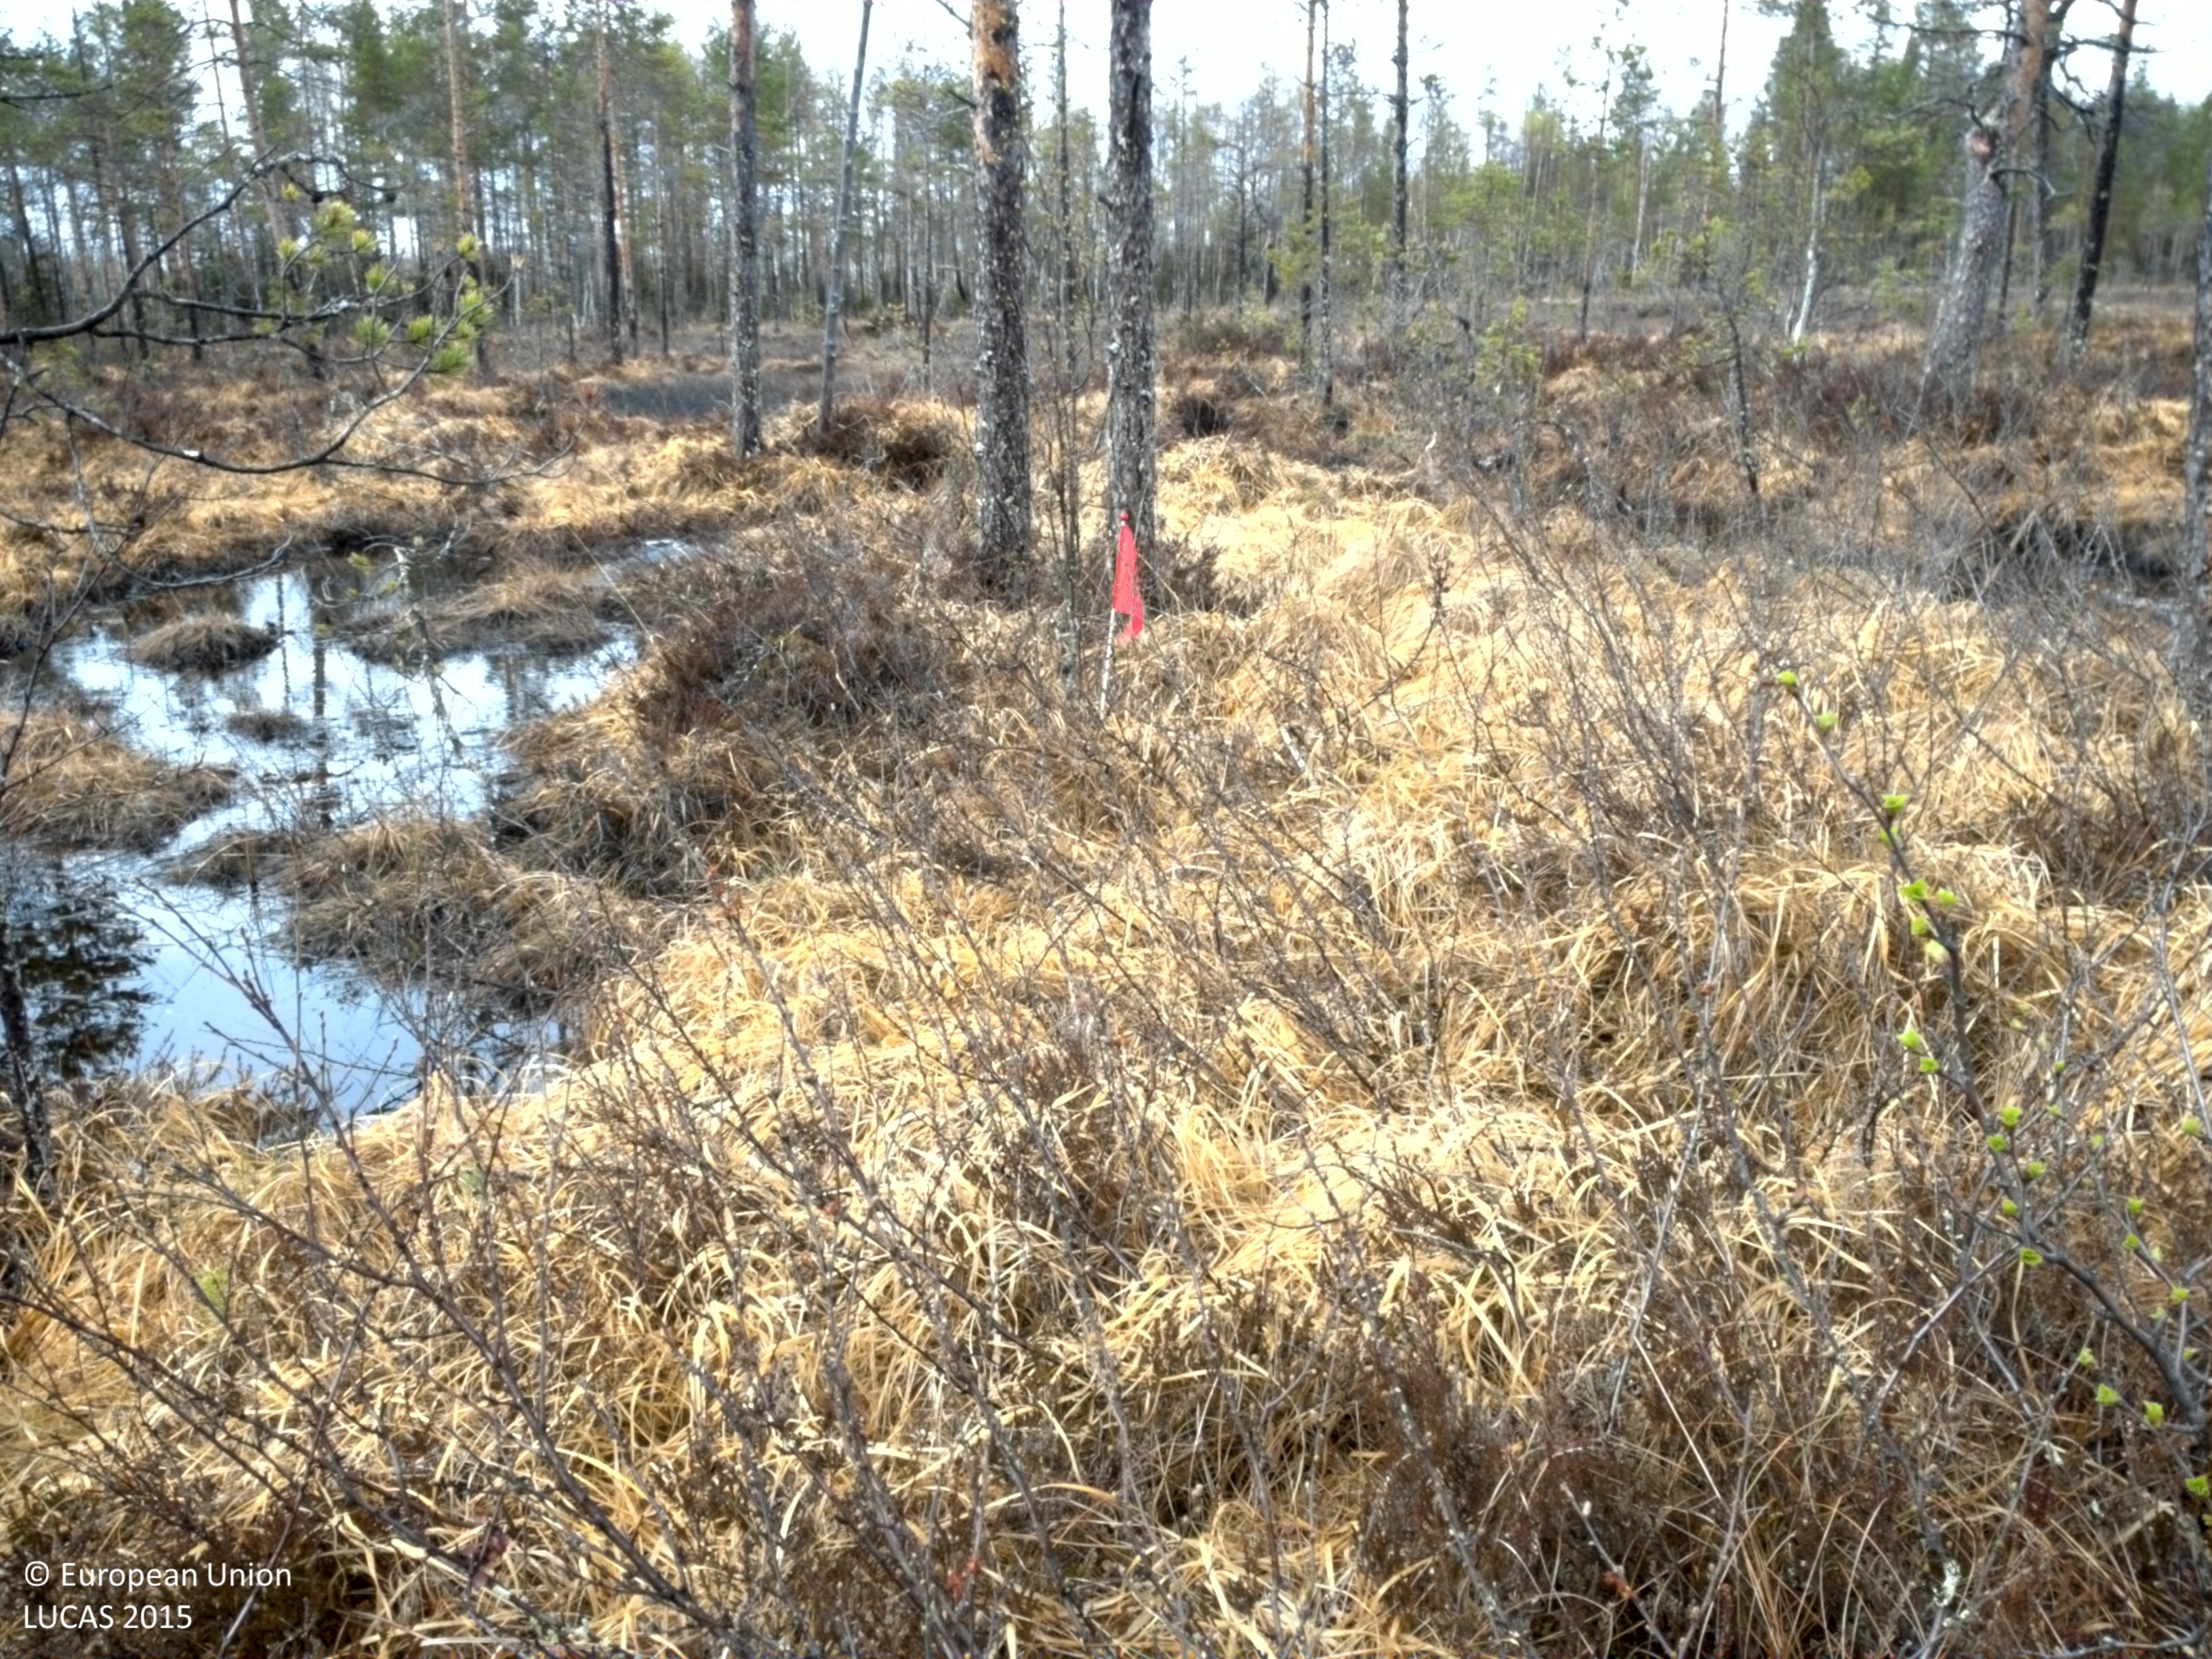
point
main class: Woodland
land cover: Pine dominated coniferous woodland
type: mire and swamp forests
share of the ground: 25 - 50 %
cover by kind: herbaceous plants 45 %, coniferous forest trees 35 %, shrubs 15 %, broadleaved forest trees 5 %
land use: Semi-natural and natural areas not in use
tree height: > 5 m
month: May
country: SE
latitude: 66.2117
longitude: 23.2485
